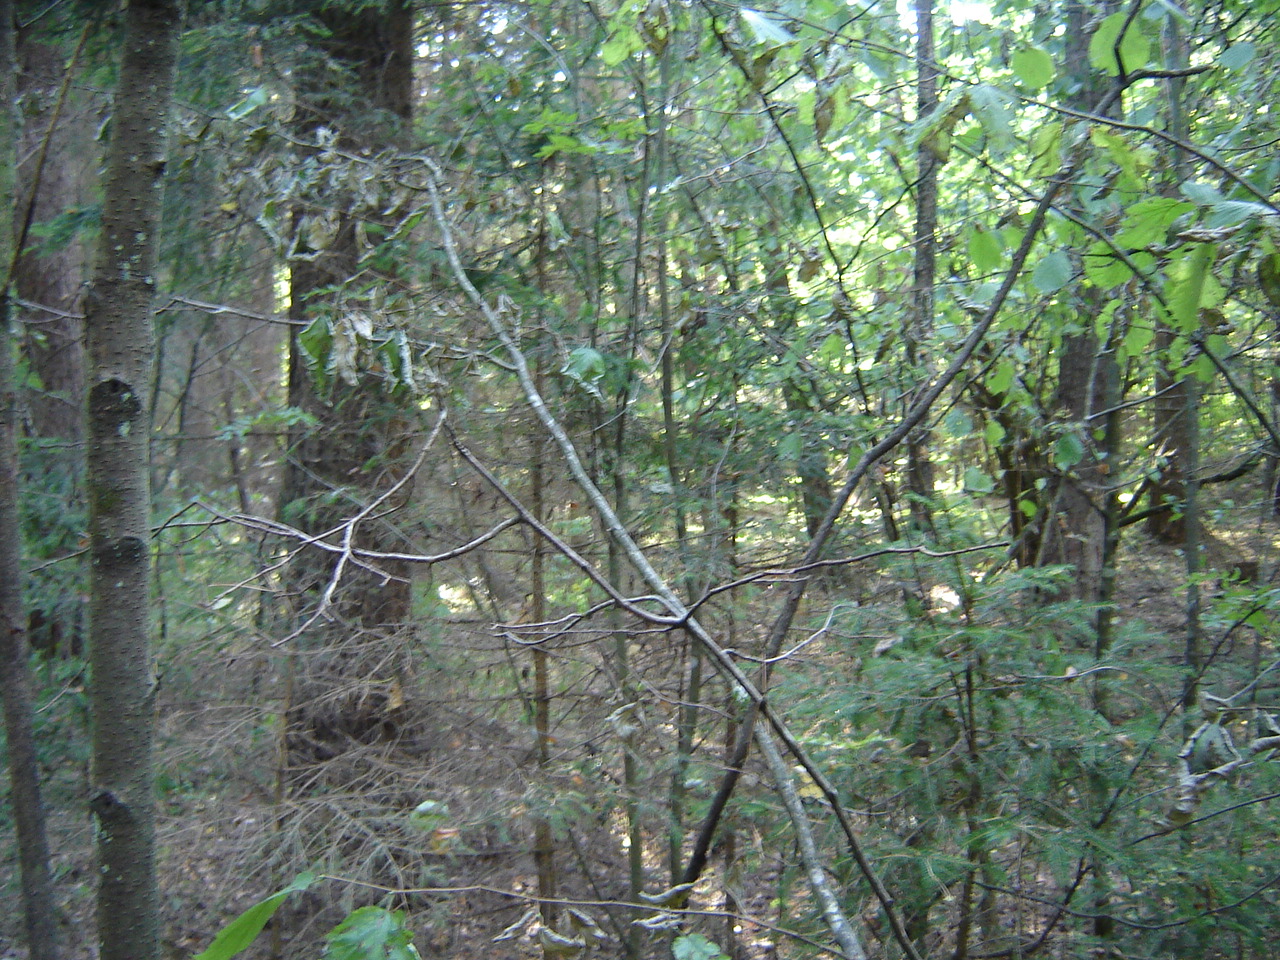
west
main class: Woodland
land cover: Pine dominated mixed woodland
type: hemiboreal forest and nemoral coniferous forest and mixed broadleaved-coniferous forest
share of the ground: > 75 %
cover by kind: coniferous forest trees 65 %, broadleaved forest trees 30 %, unconsolidated bare surface 5 %
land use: Forestry
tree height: > 5 m
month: August
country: LT
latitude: 54.5242
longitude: 24.7401
